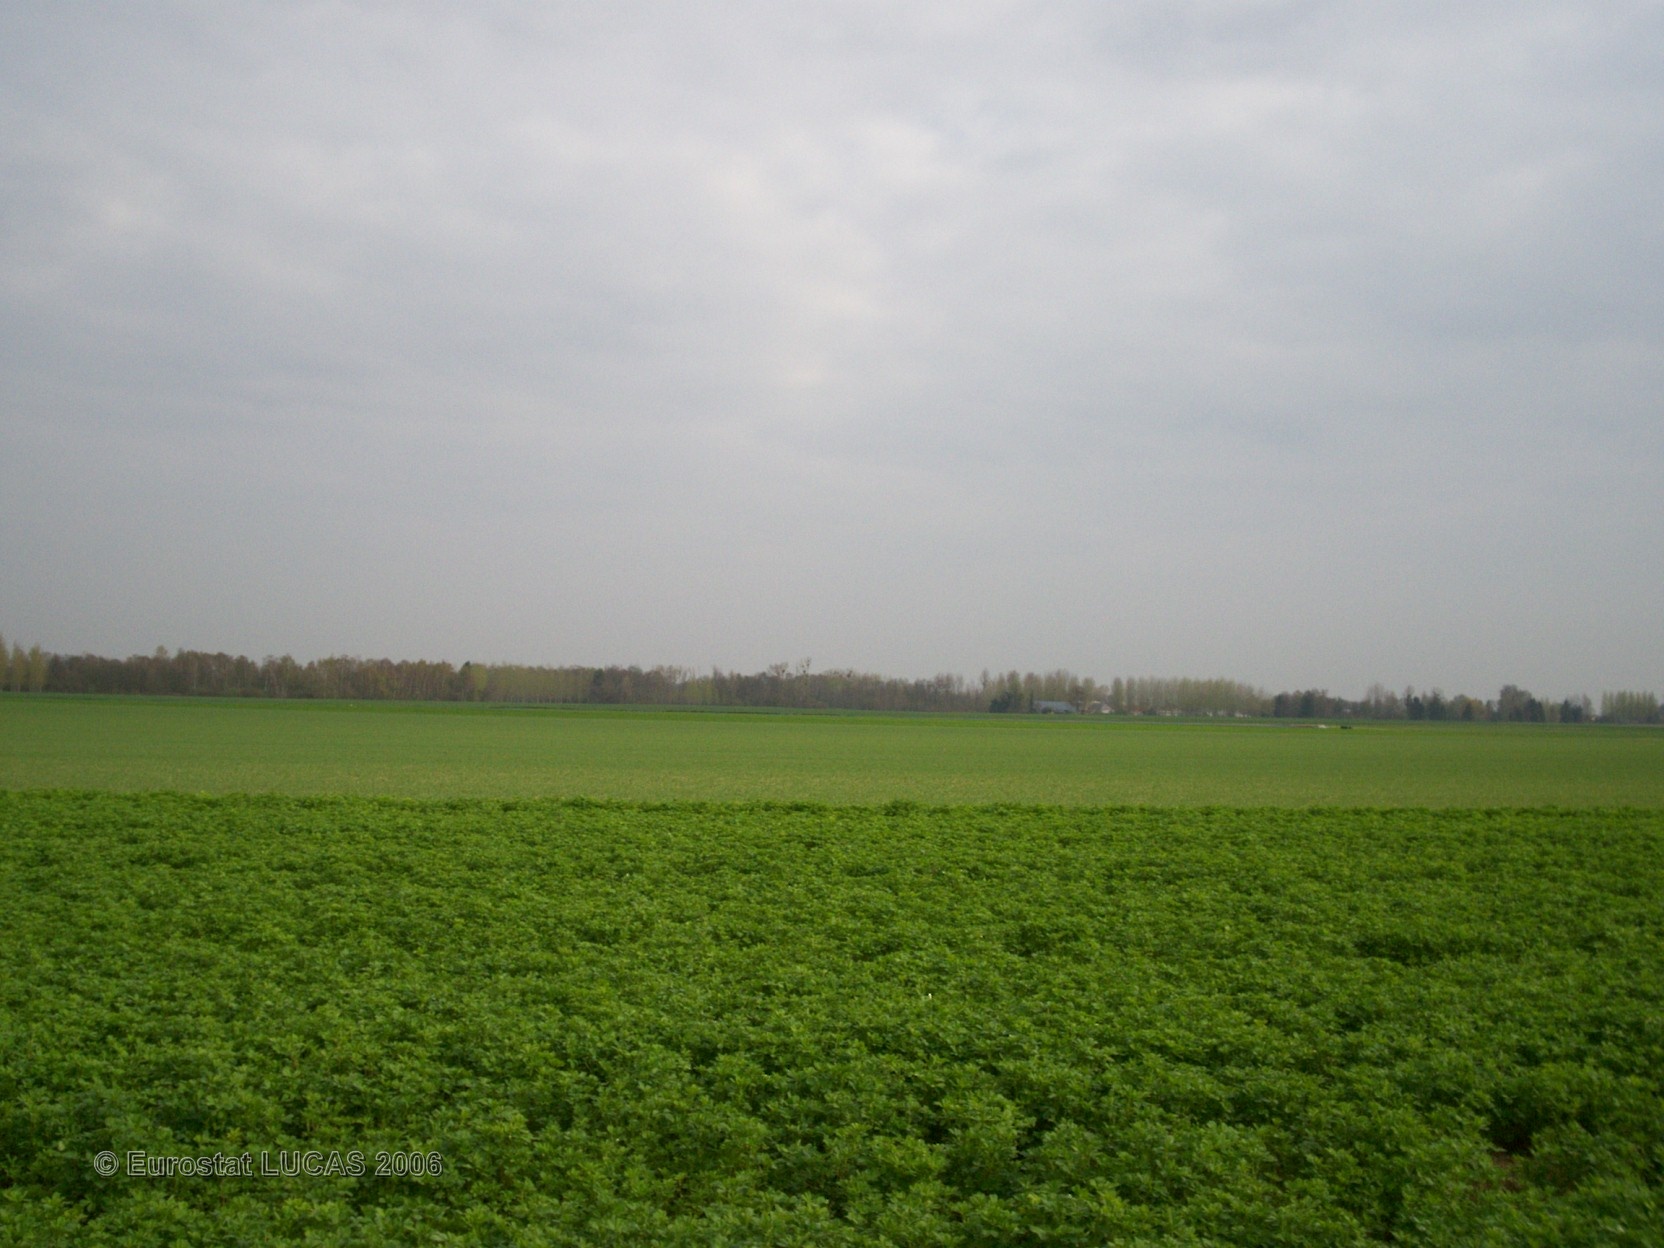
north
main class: Cropland
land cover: Lucerne
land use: Agriculture (excluding fallow land and kitchen gardens)
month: April
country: FR
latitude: 48.6337
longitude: 3.9298
